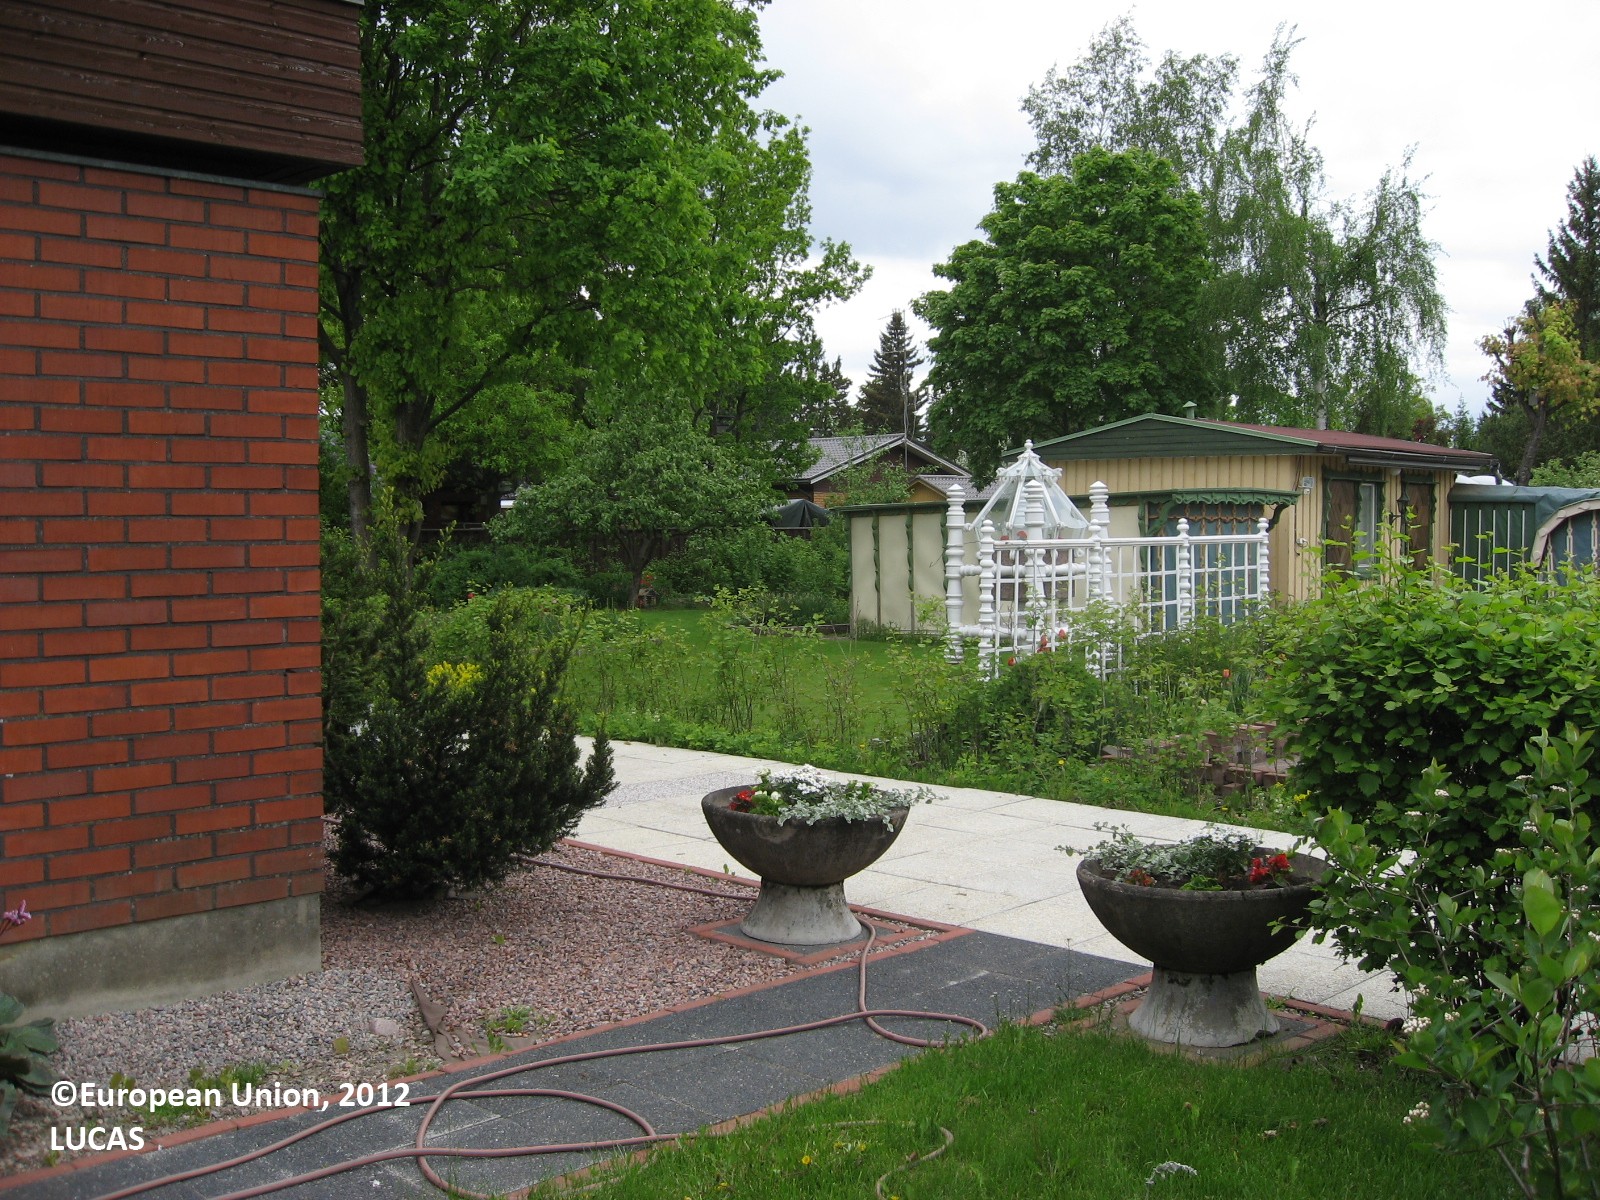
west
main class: Grassland
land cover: Grassland with sparse tree/shrub cover
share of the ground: > 75 %
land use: Residential
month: June
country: FI
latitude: 60.2900
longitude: 25.0061
